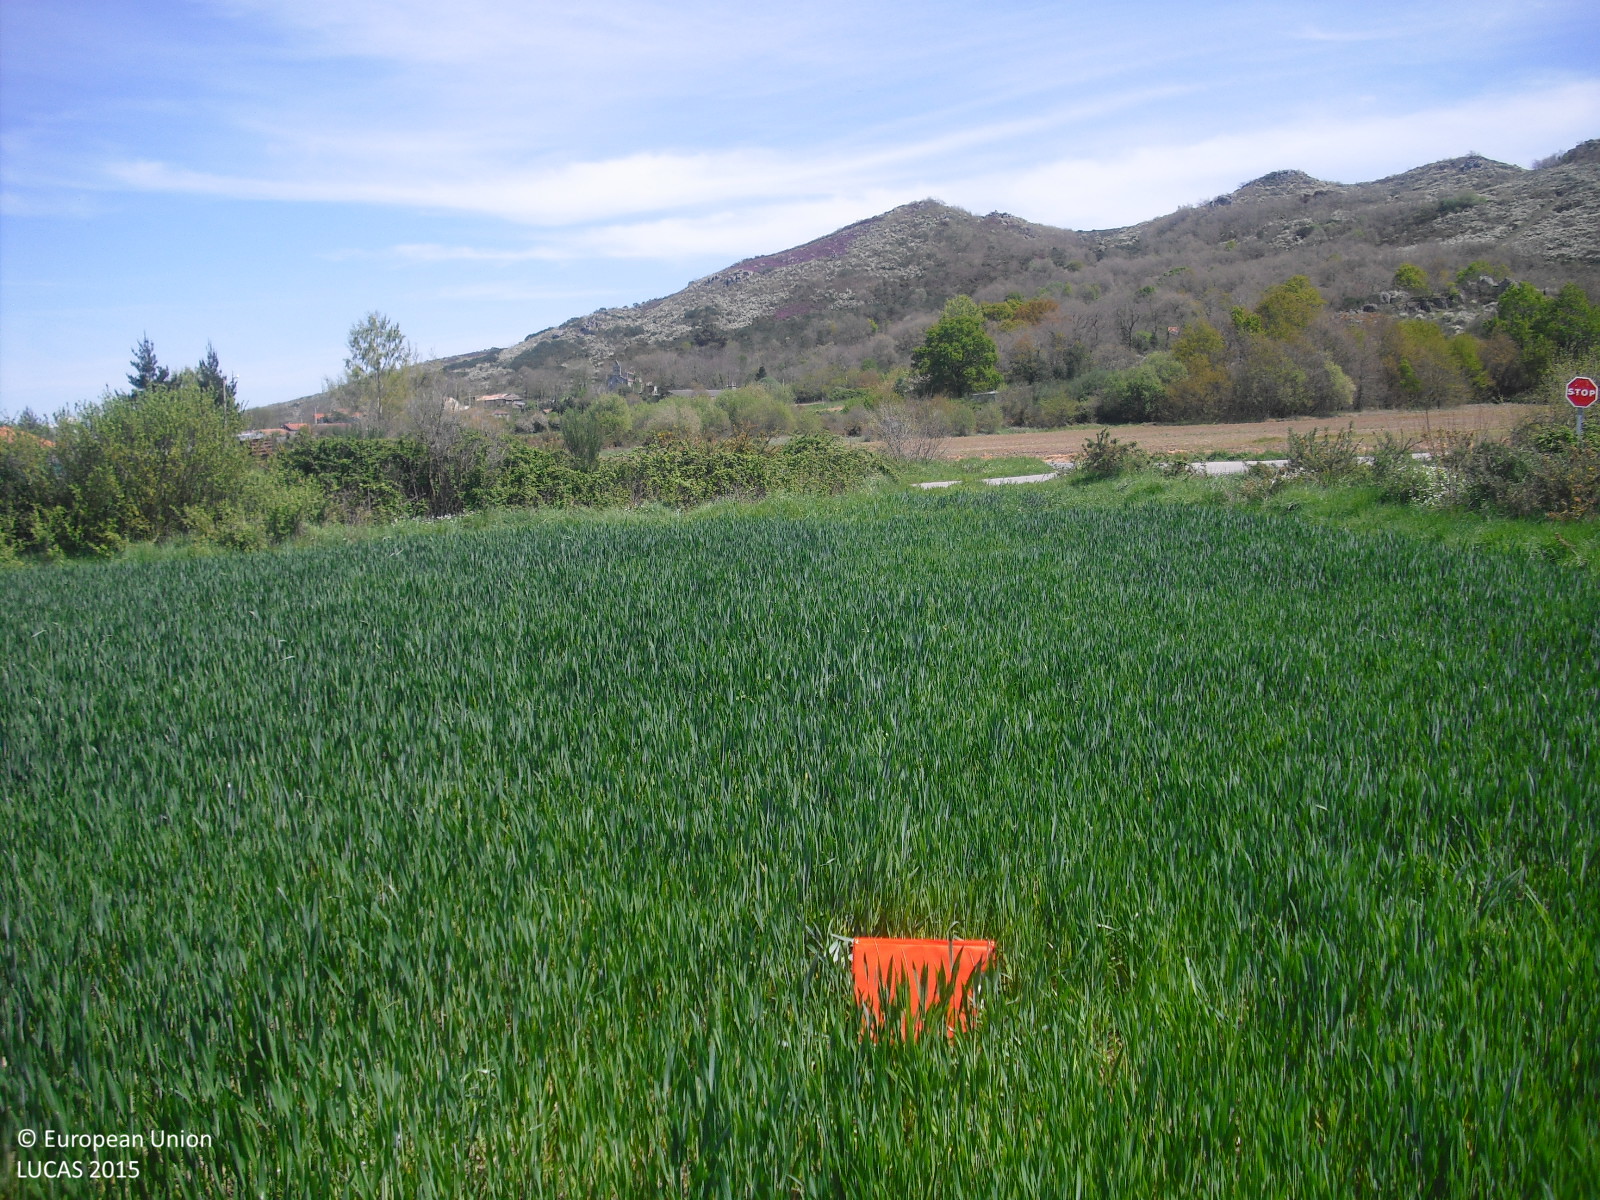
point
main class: Cropland
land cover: Common wheat
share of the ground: < 10 %
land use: Agriculture (excluding fallow land and kitchen gardens)
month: April
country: ES
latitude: 42.0365
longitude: -7.7173
